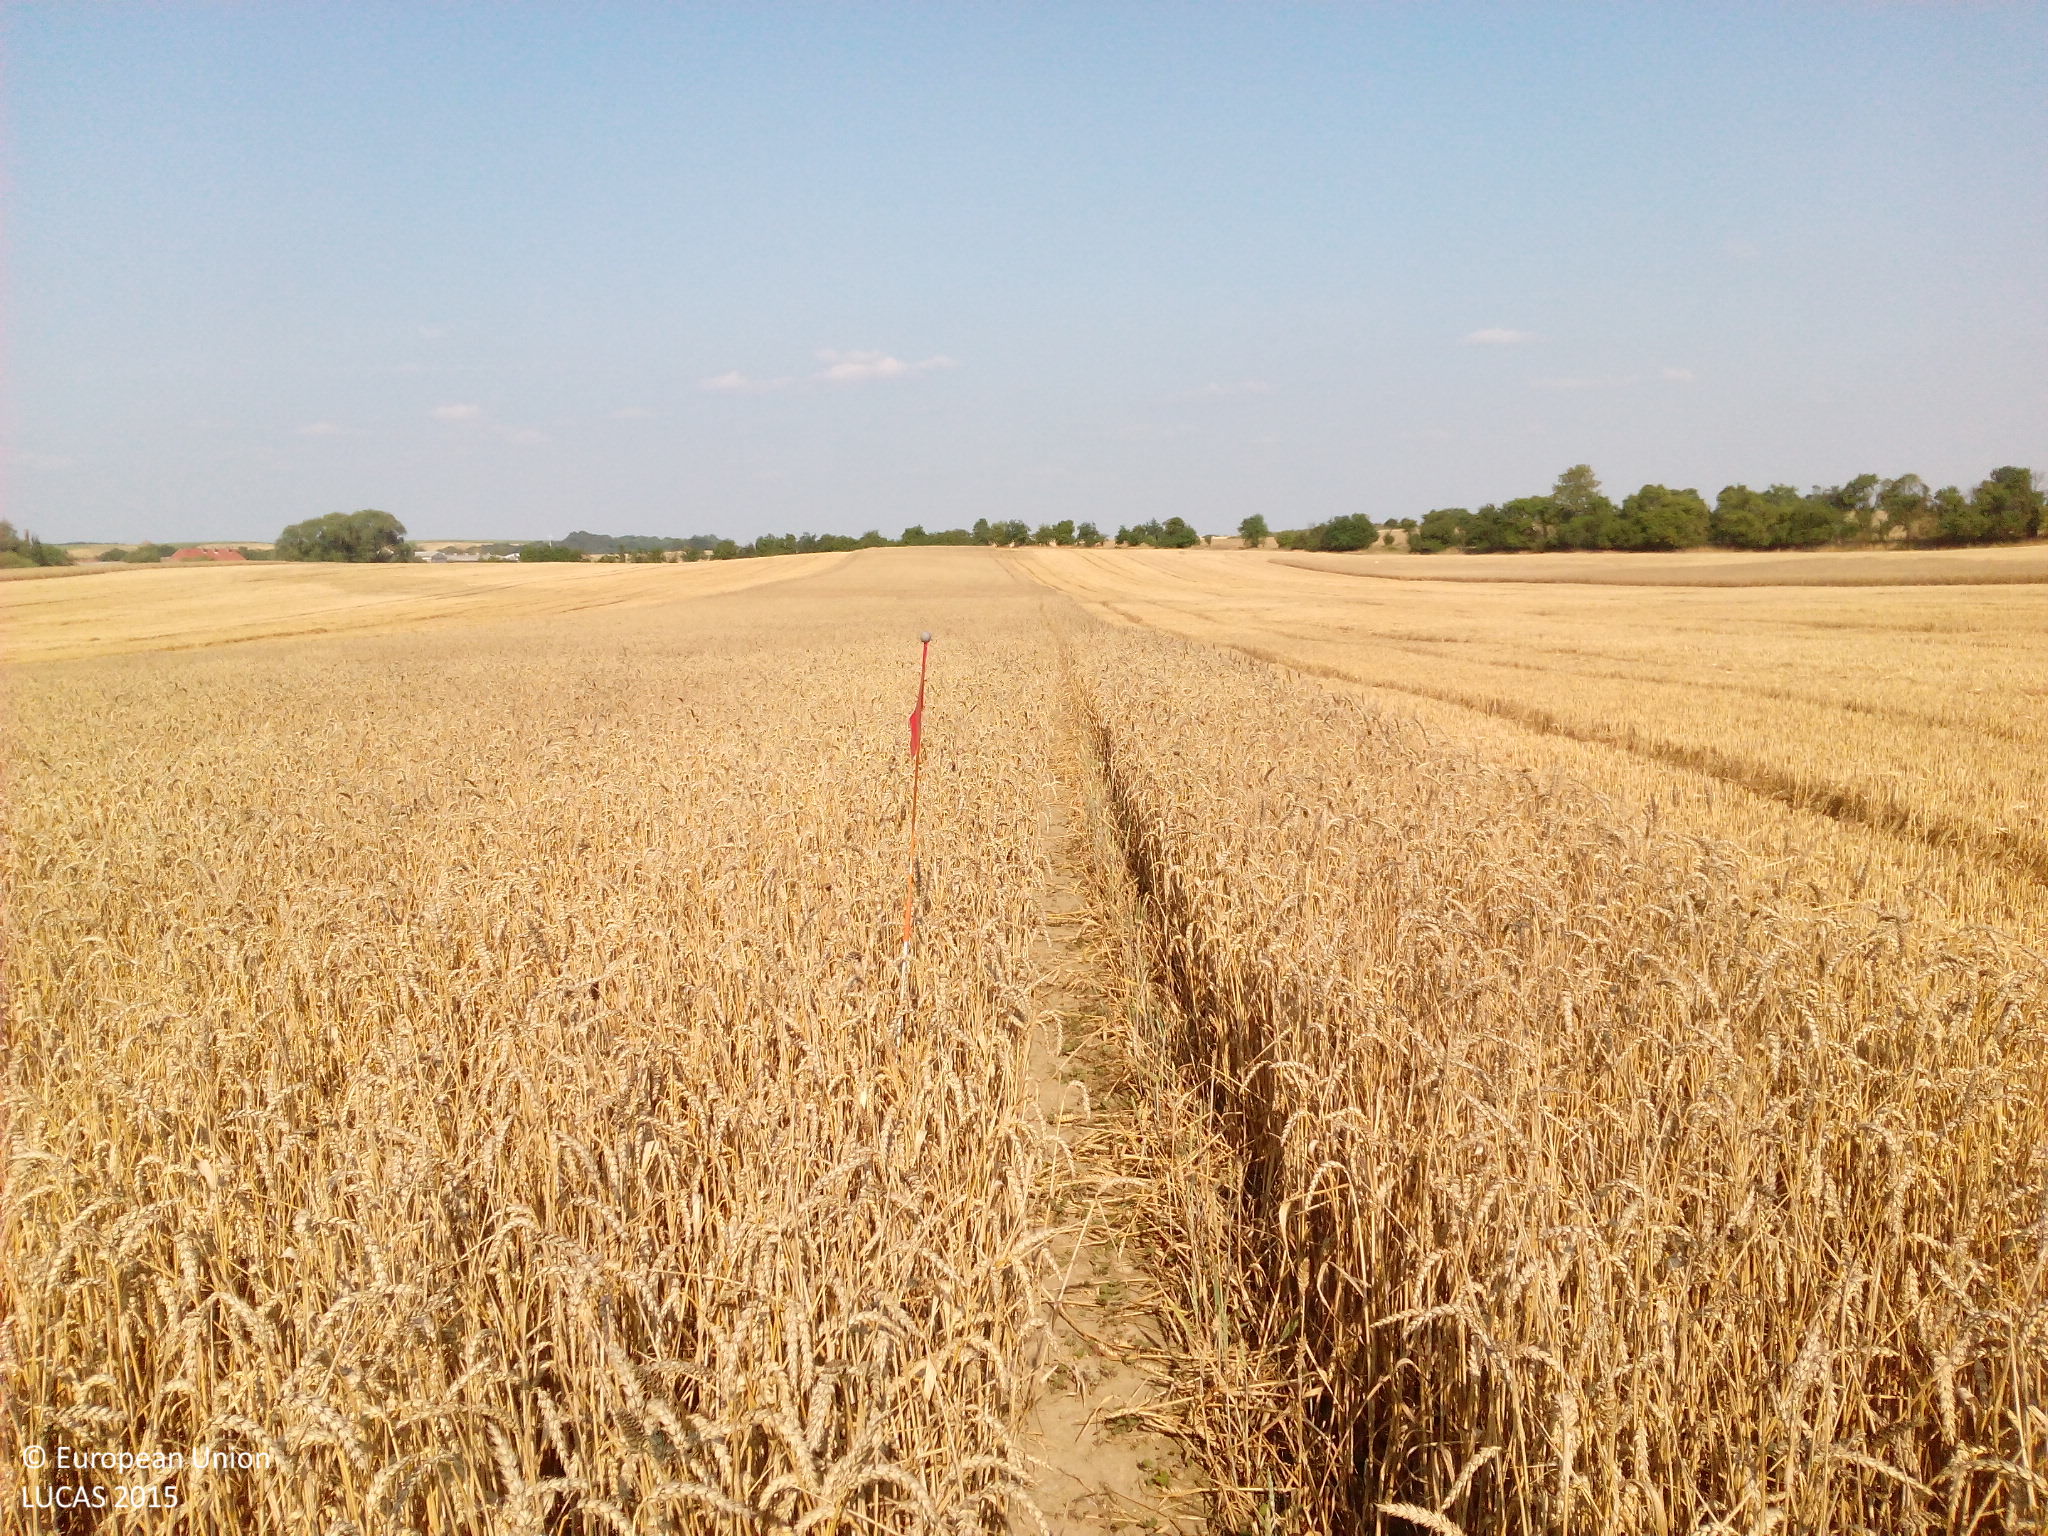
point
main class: Cropland
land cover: Common wheat
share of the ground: > 75 %
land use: Agriculture (excluding fallow land and kitchen gardens)
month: August
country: DE
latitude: 53.0245
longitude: 14.1604
